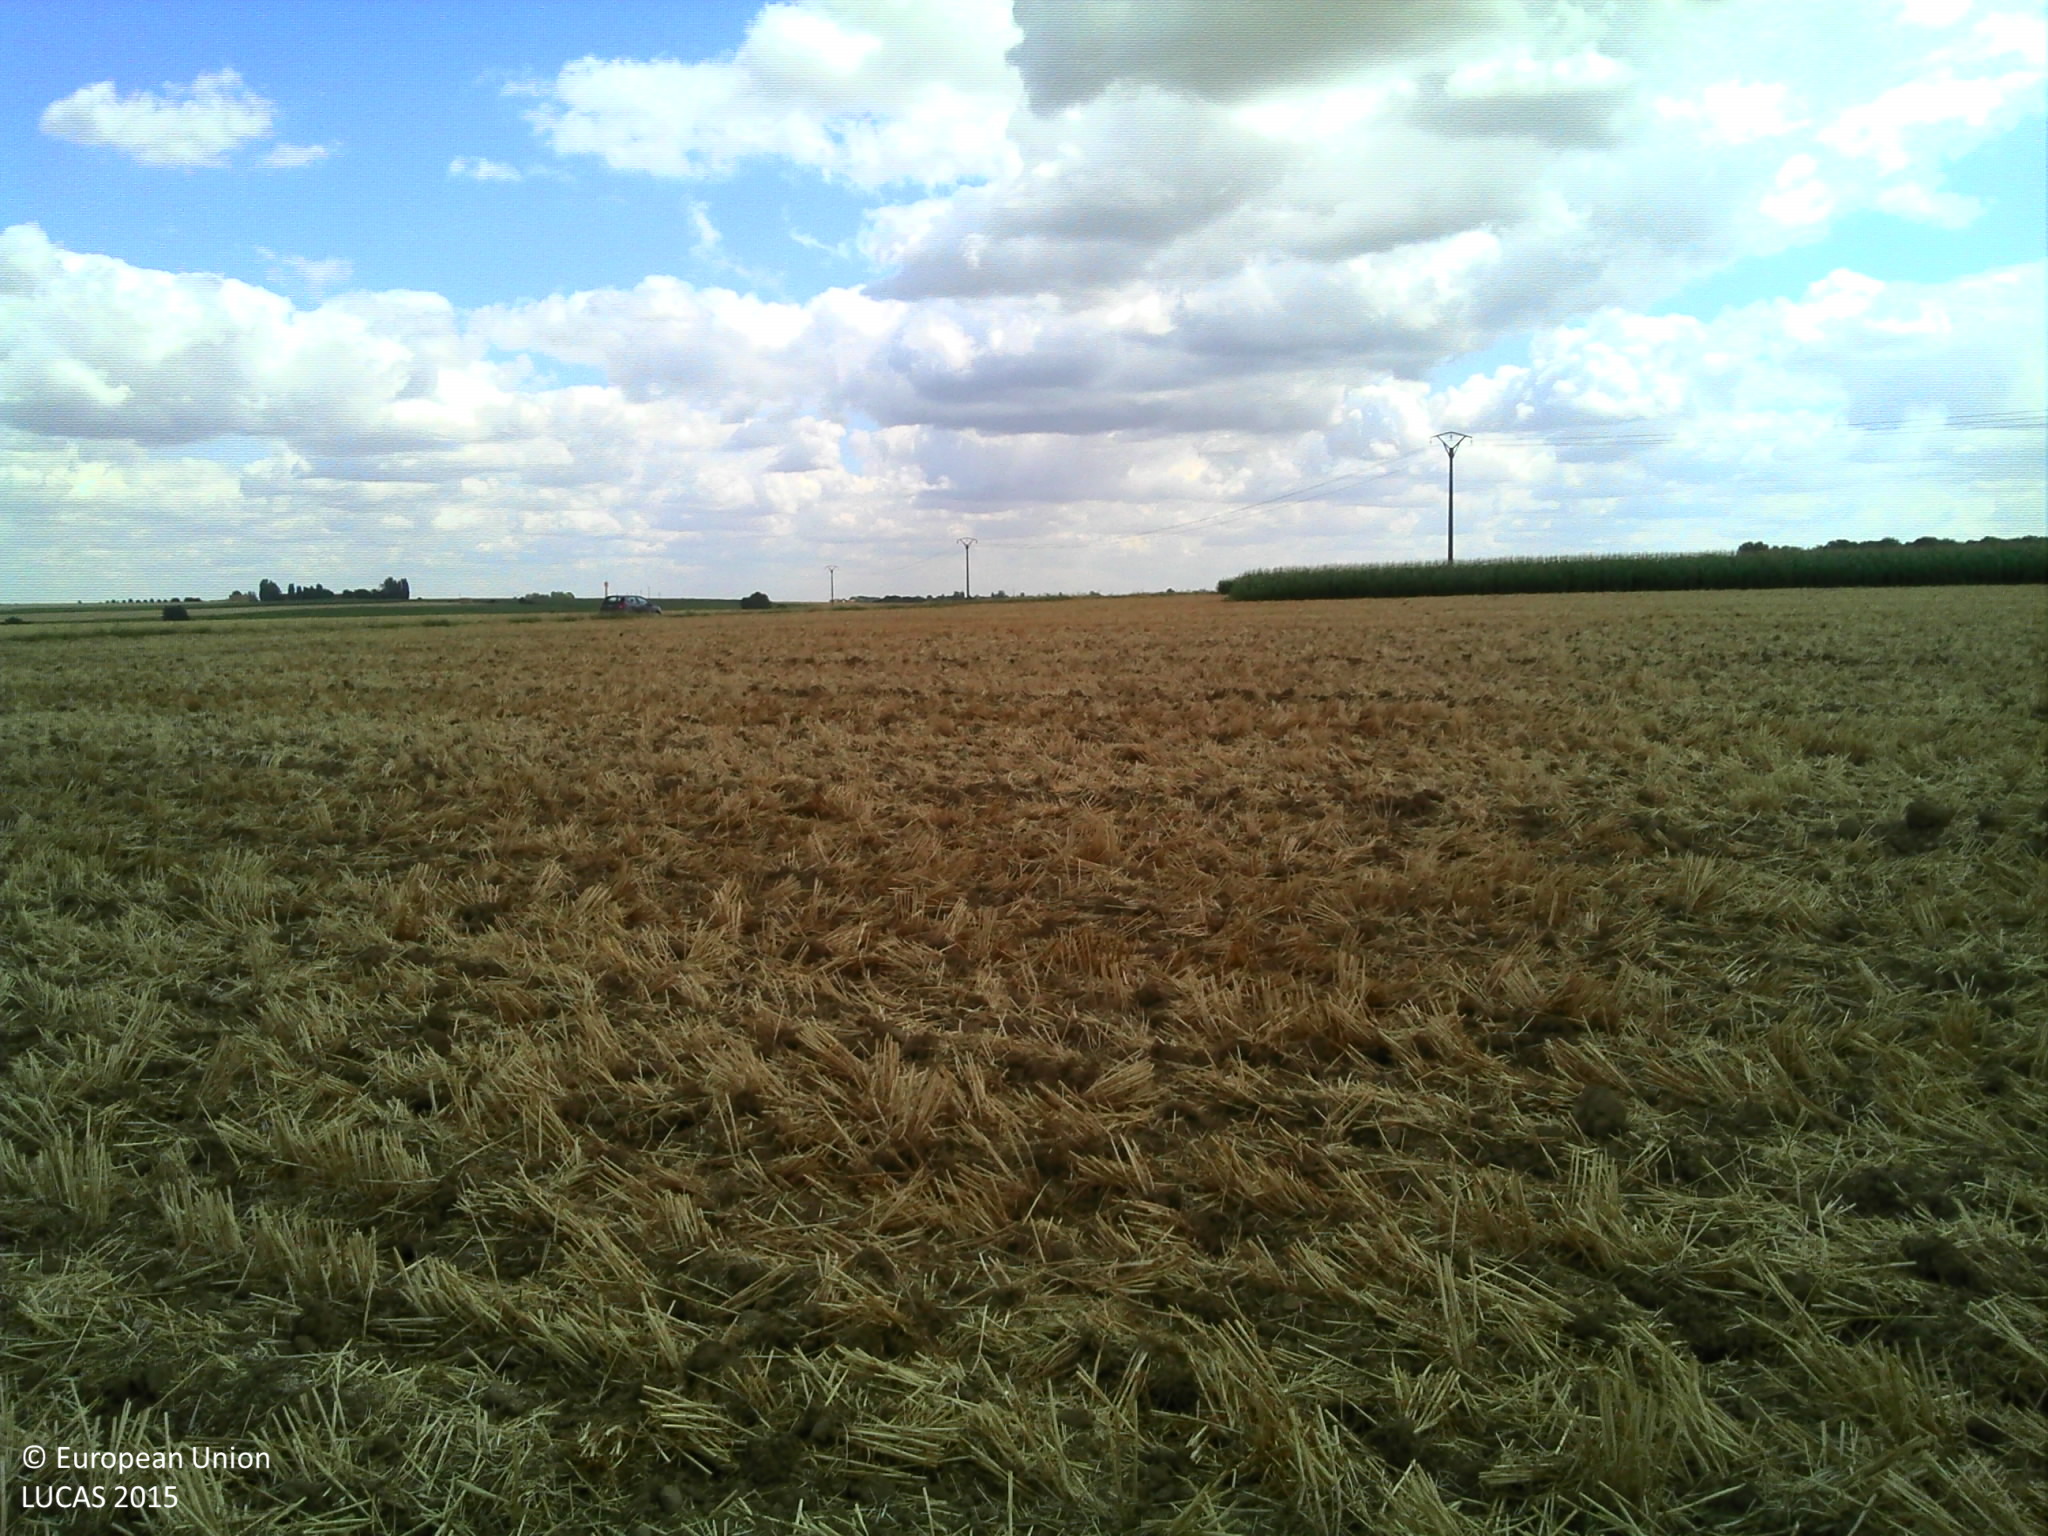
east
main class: Cropland
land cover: Common wheat
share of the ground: > 75 %
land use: Agriculture (excluding fallow land and kitchen gardens)
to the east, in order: Common wheat; Grass margins; Tracks; Grass margins; Common wheat
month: July
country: FR
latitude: 48.6315
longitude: 2.9764
